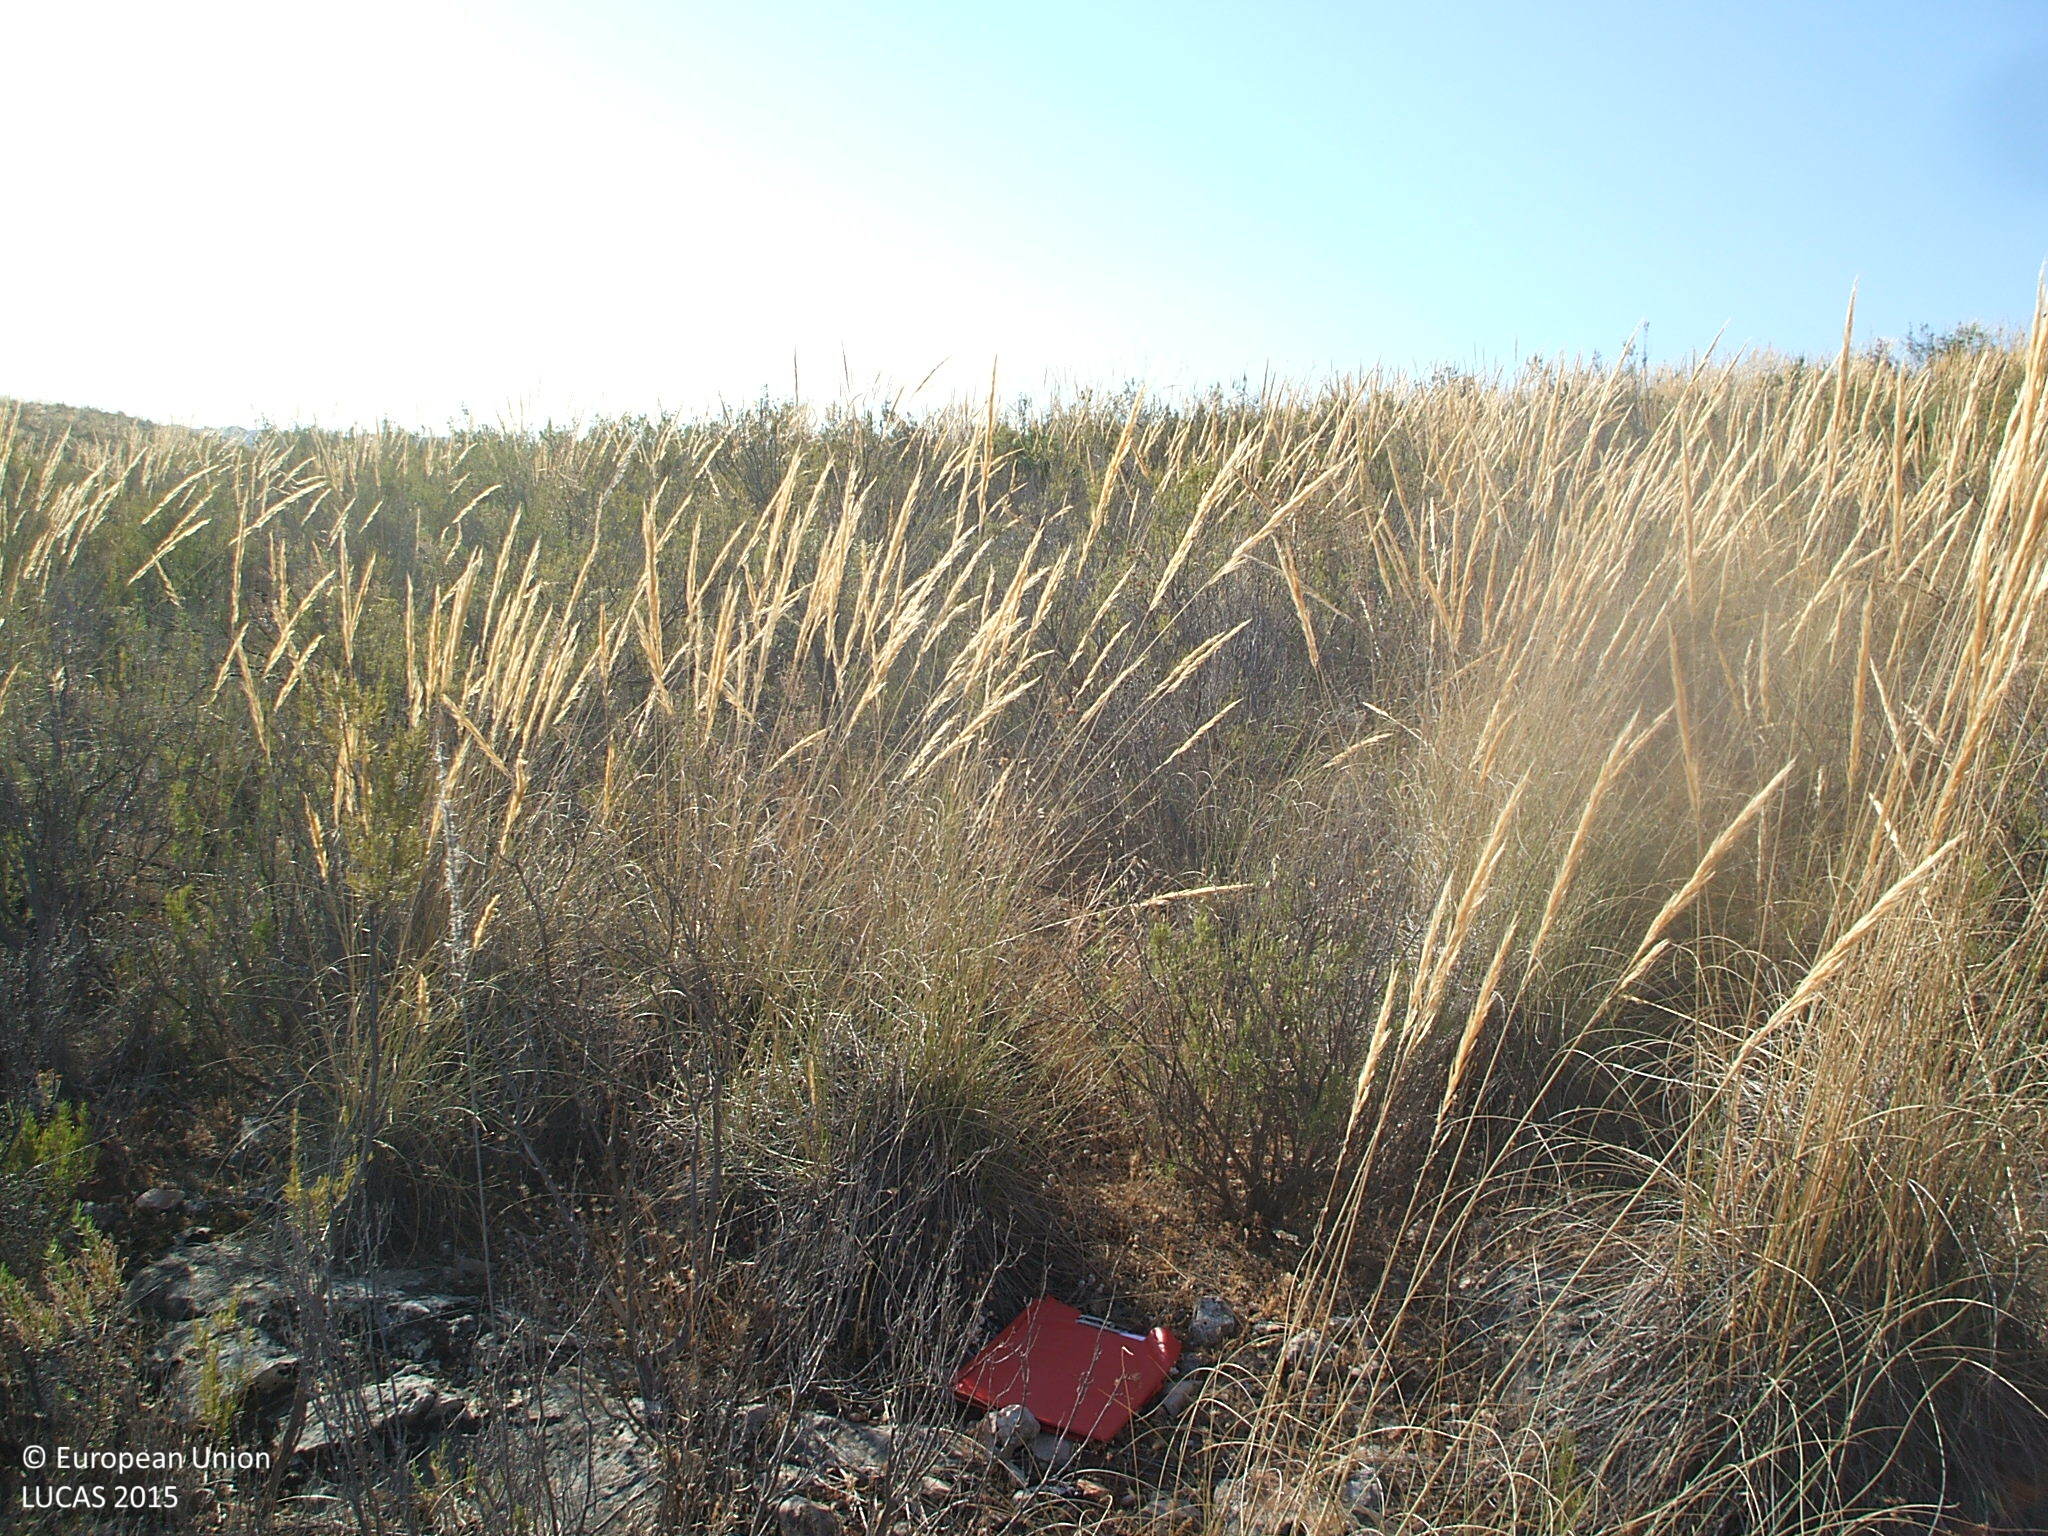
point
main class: Shrubland
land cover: Shrubland without tree cover
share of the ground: 25 - 50 %
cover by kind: shrubs 40 %, herbaceous plants 40 %, consolidated bare surface 20 %
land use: Semi-natural and natural areas not in use
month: July
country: ES
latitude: 37.2863
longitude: -2.2184
